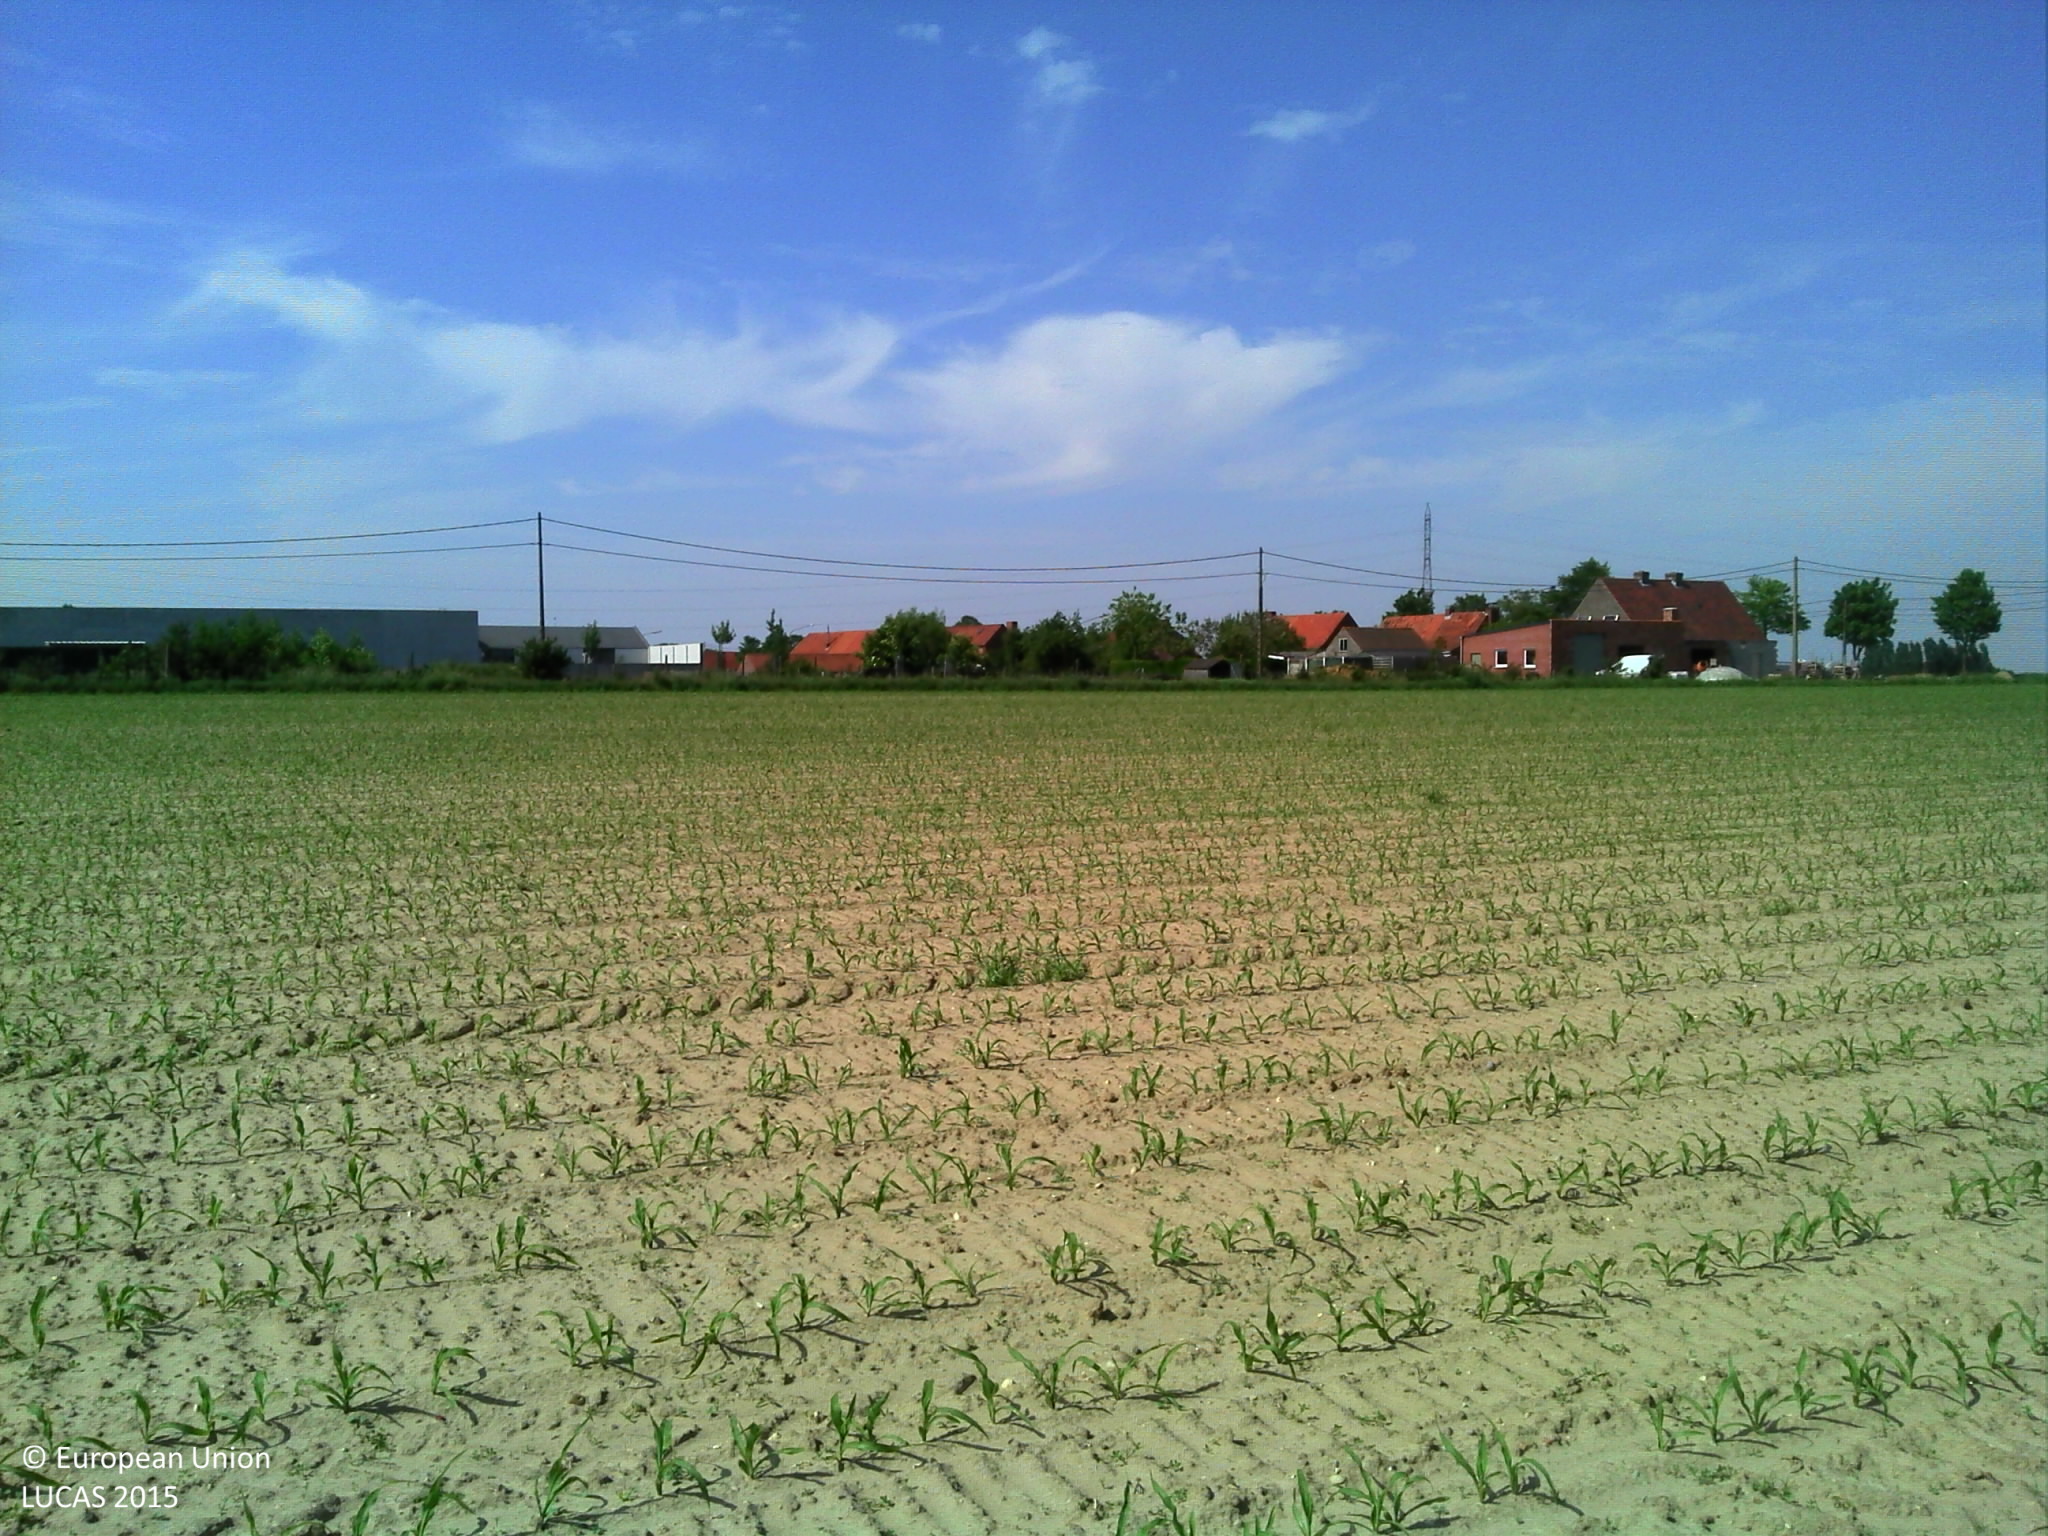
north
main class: Cropland
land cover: Maize
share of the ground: < 10 %
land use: Agriculture (excluding fallow land and kitchen gardens)
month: June
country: BE
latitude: 50.8543
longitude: 3.0152
